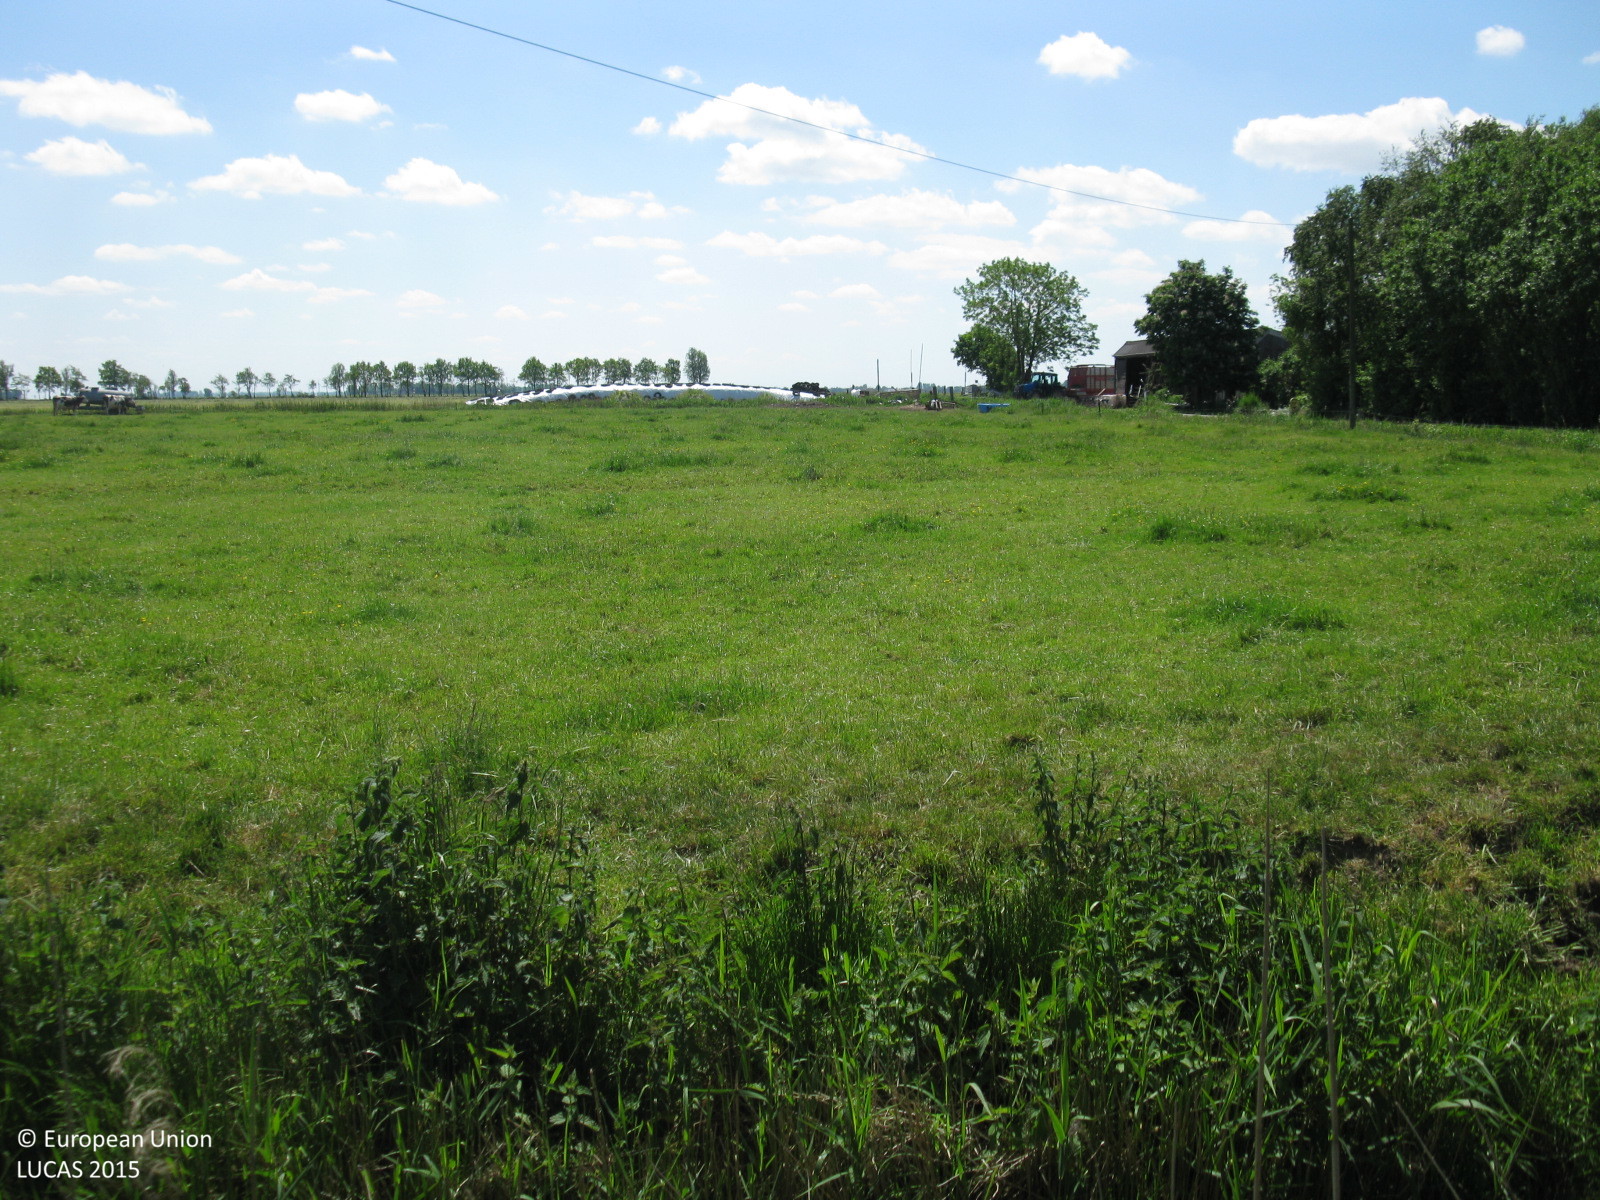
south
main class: Grassland
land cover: Grassland without tree/shrub cover
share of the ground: > 75 %
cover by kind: herbaceous plants 100 %
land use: Agriculture (excluding fallow land and kitchen gardens)
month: June
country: DE
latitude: 53.2996
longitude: 7.2847
